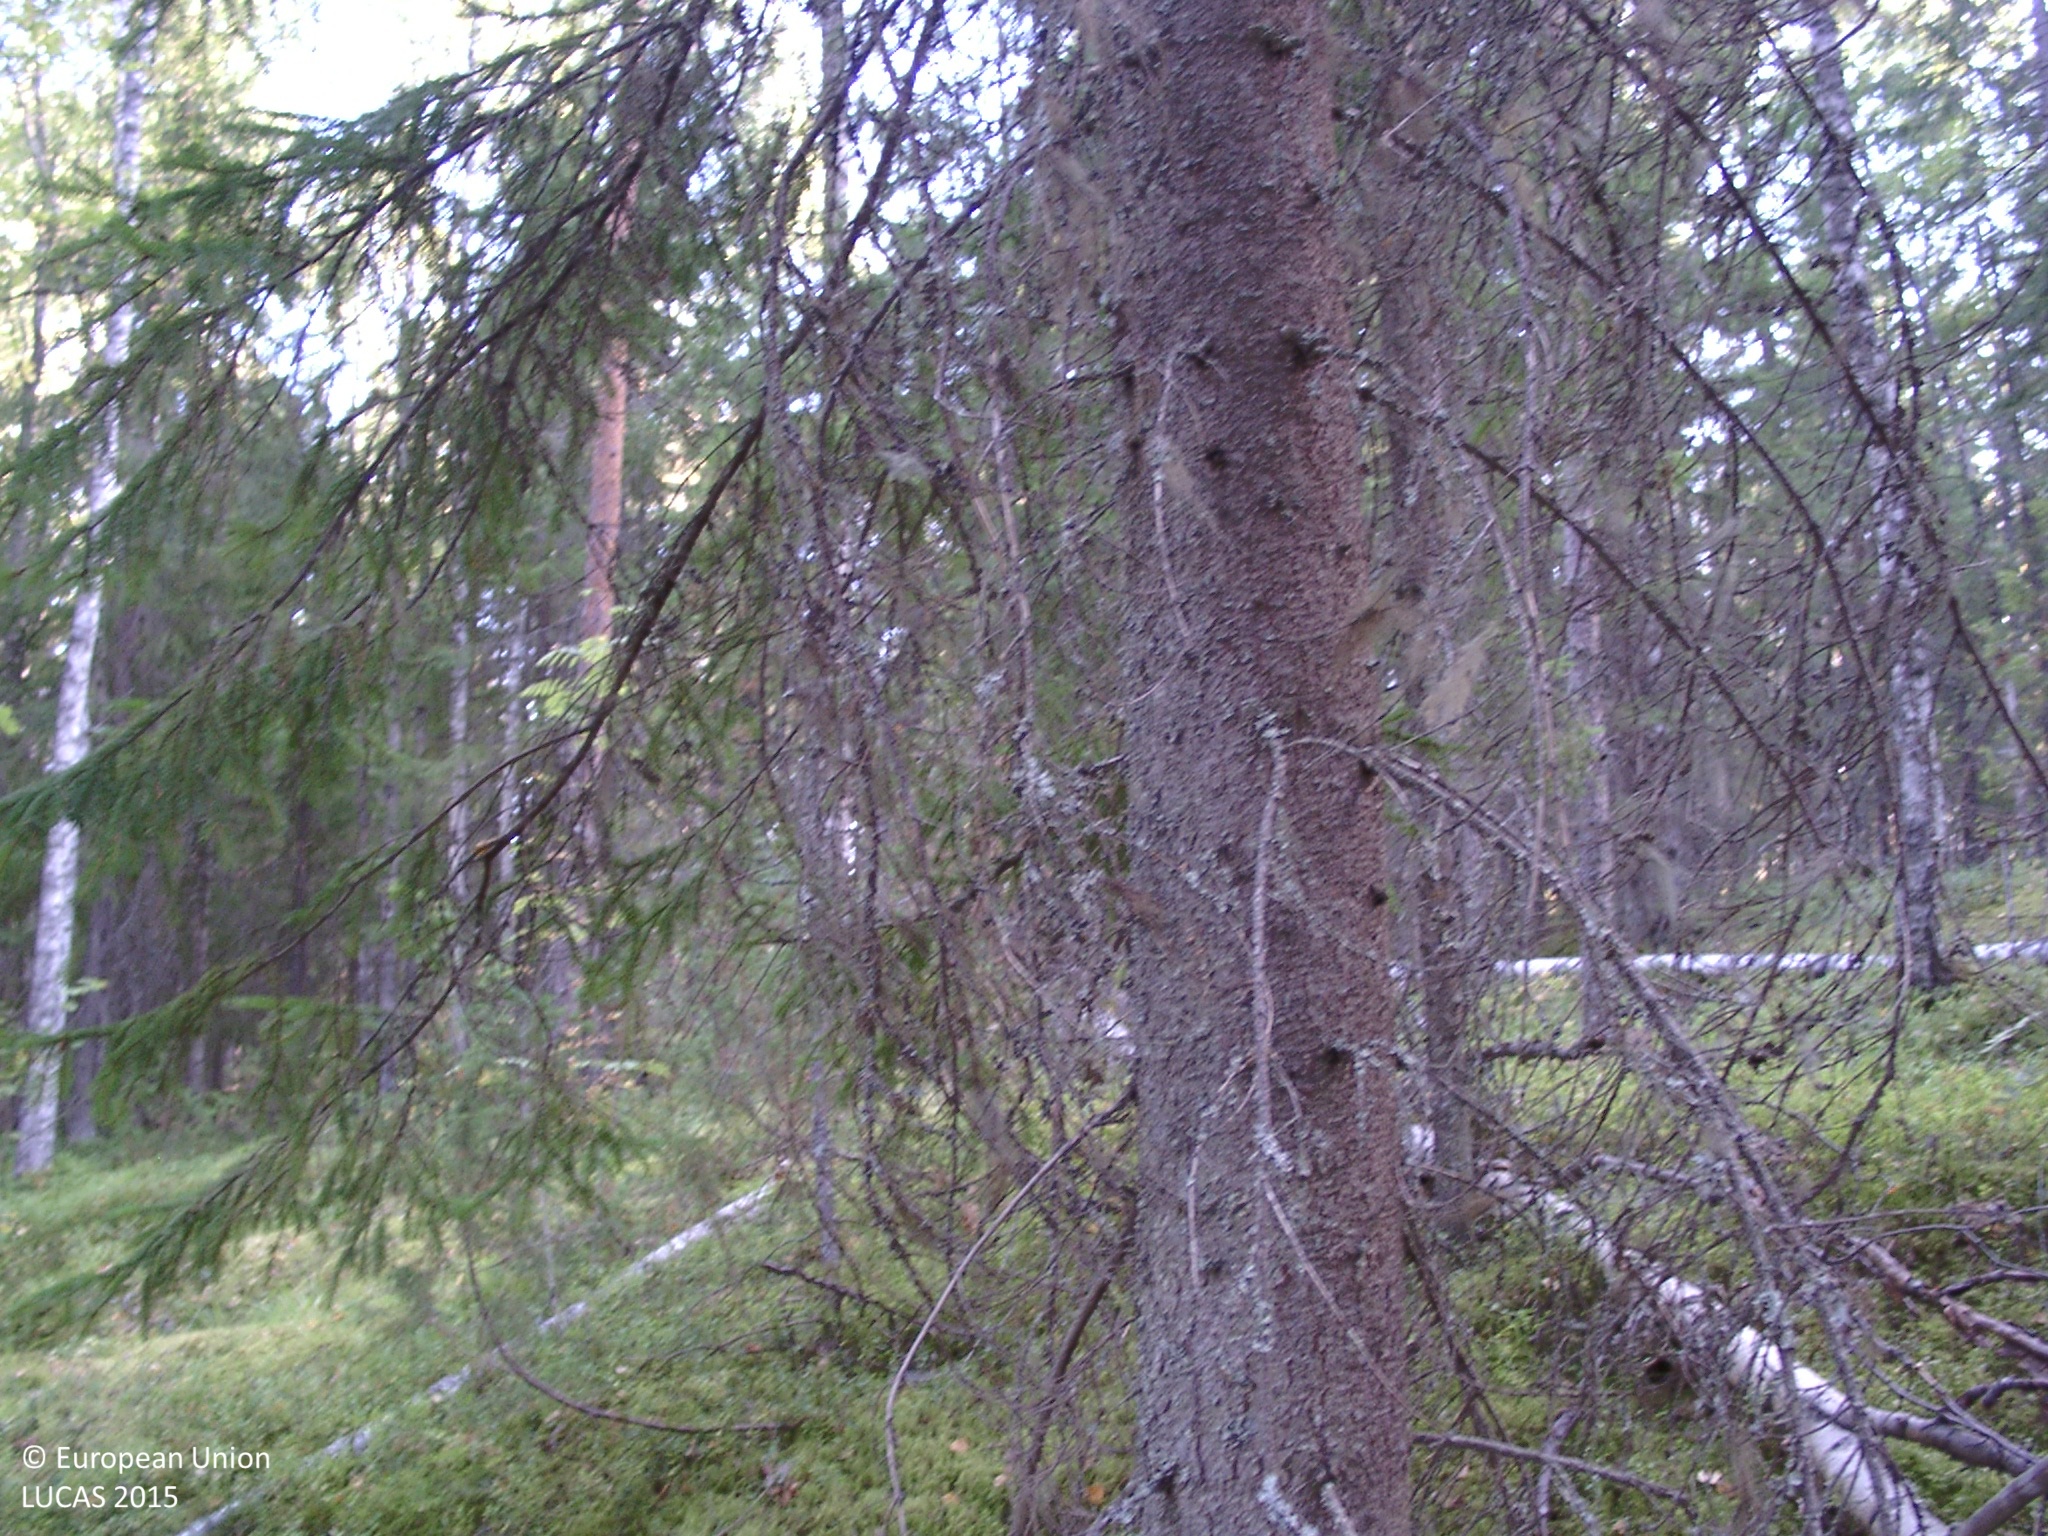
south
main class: Woodland
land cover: Spruce dominated mixed woodland
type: boreal forest
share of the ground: 50 - 75 %
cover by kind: coniferous forest trees 45 %, broadleaved forest trees 20 %, shrubs 20 %, lichens and mosses 15 %
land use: Forestry
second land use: Sport
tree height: > 5 m
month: August
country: FI
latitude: 61.8972
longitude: 25.1231
